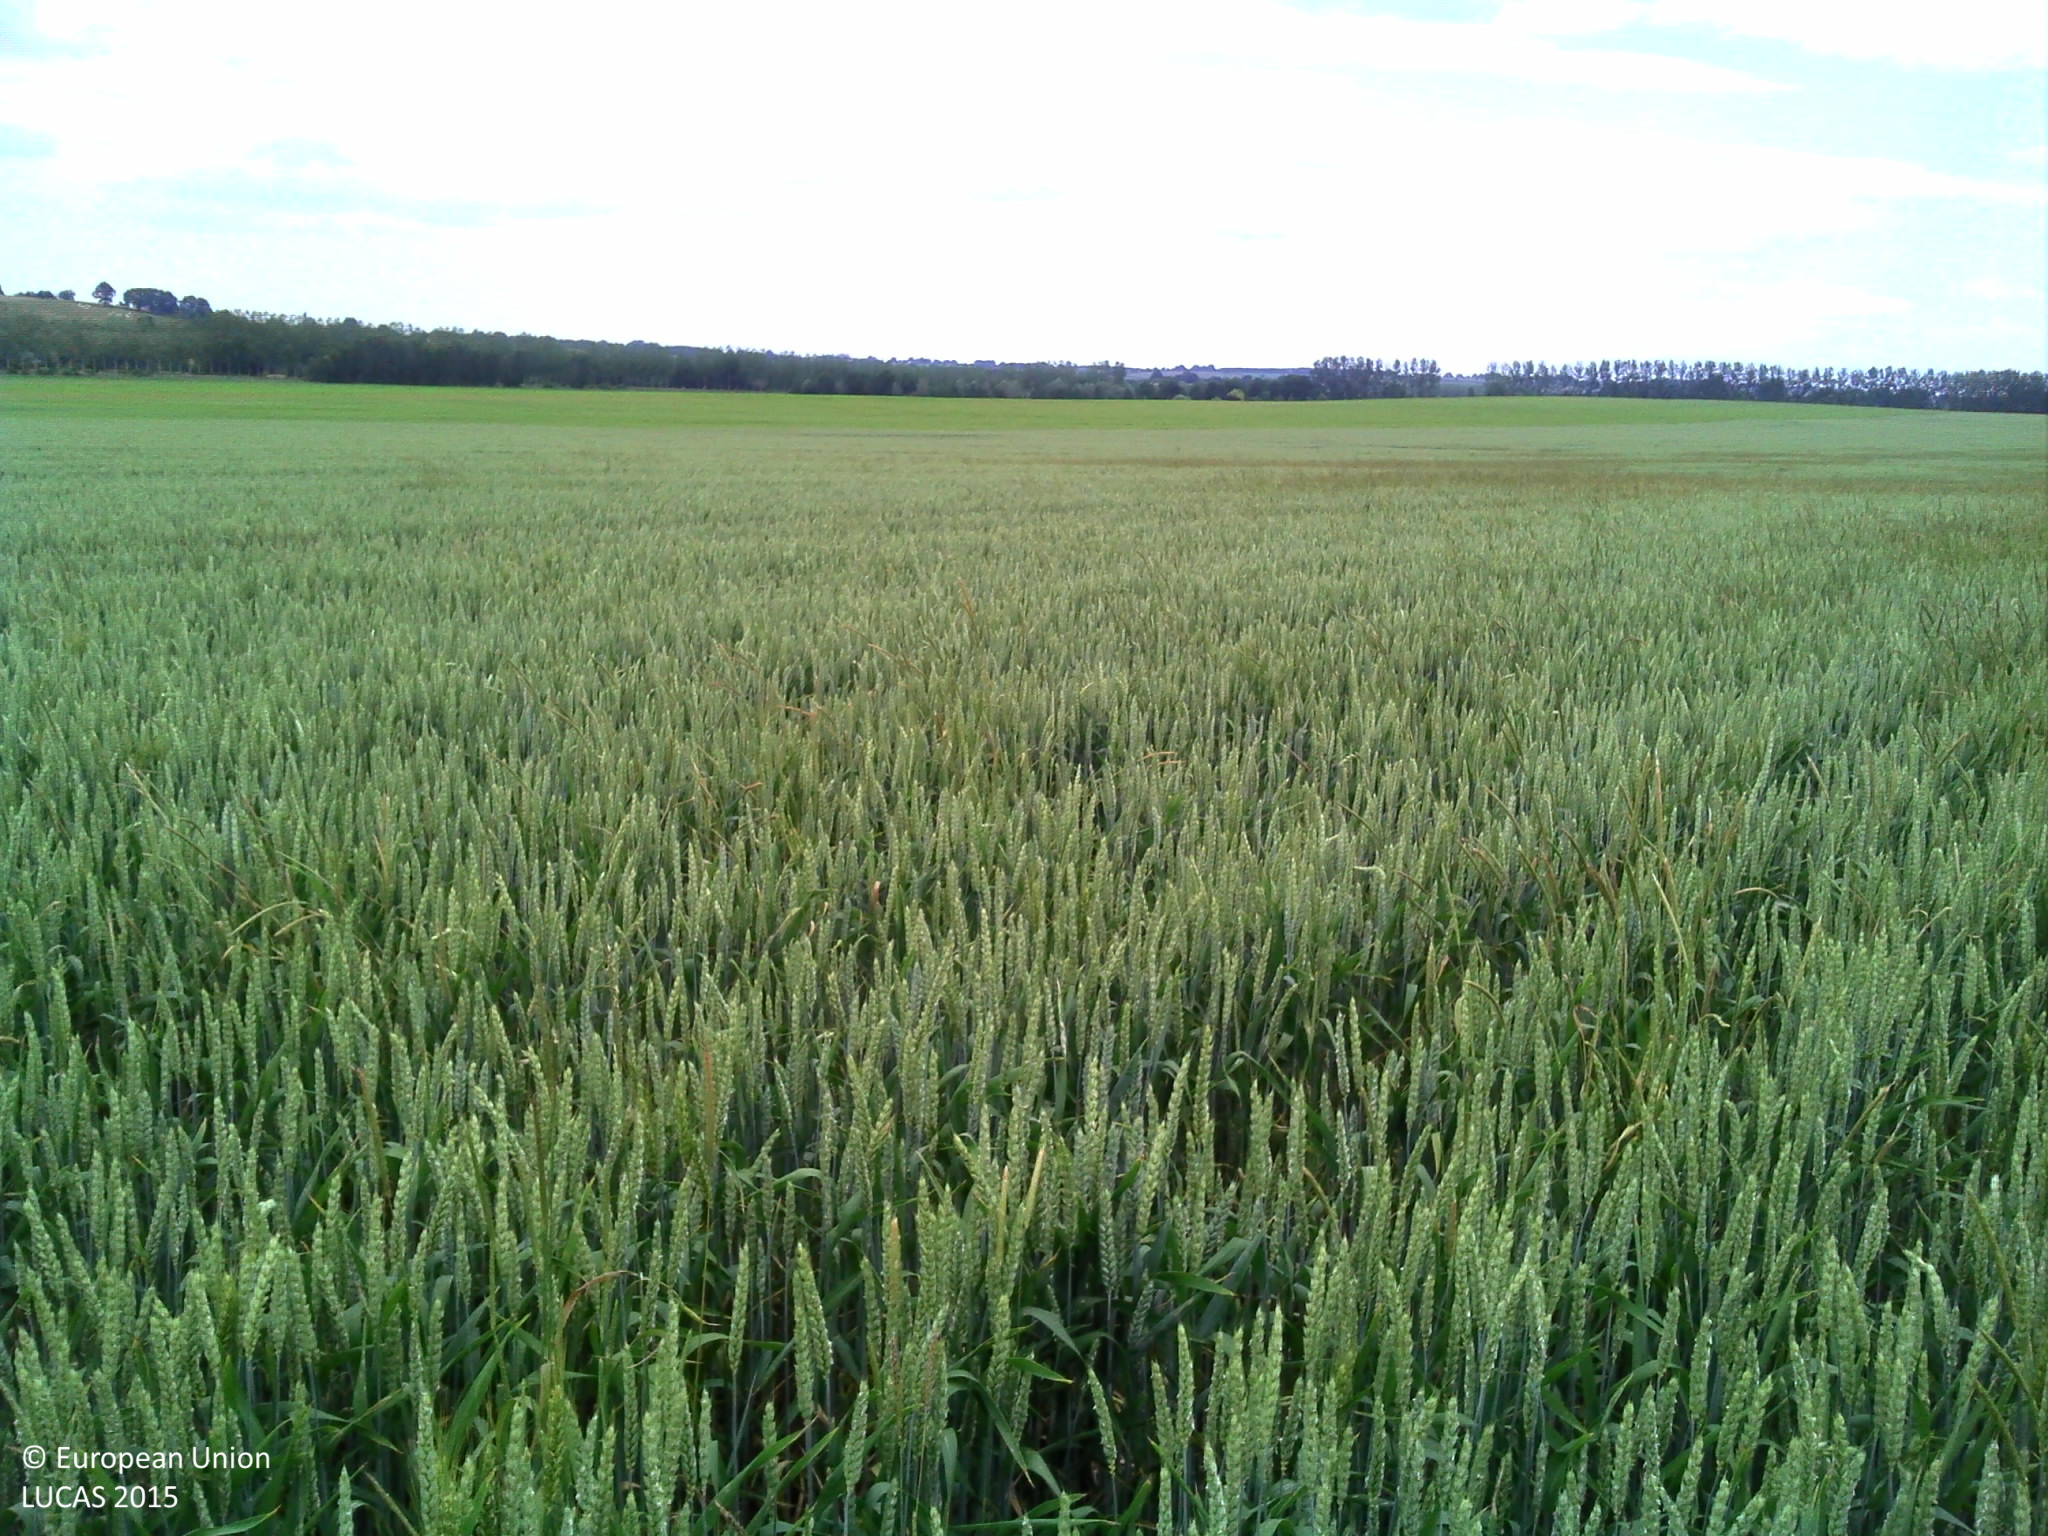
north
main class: Cropland
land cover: Common wheat
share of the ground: > 75 %
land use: Agriculture (excluding fallow land and kitchen gardens)
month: June
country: FR
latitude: 46.7885
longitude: 2.6985
